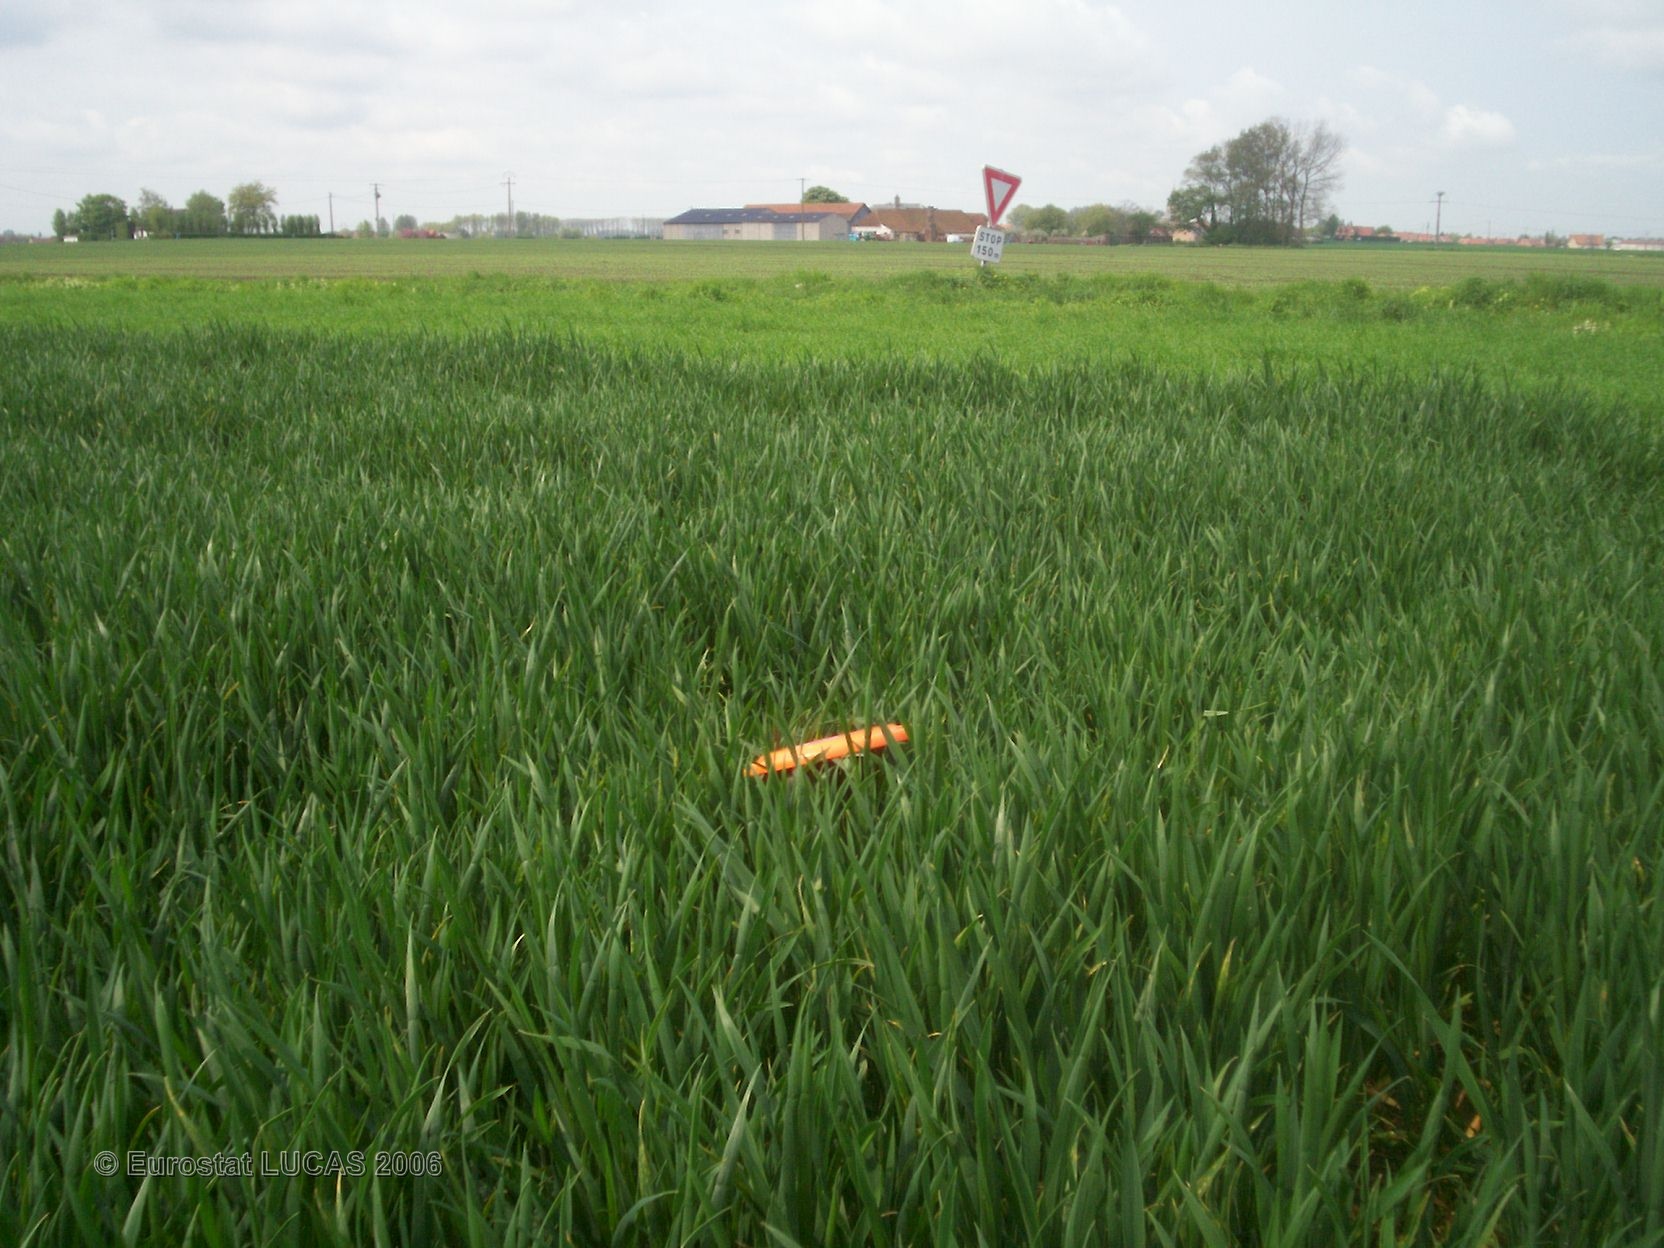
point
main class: Cropland
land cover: Common wheat
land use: Agriculture (excluding fallow land and kitchen gardens)
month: May
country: FR
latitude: 50.9165
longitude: 2.2907
